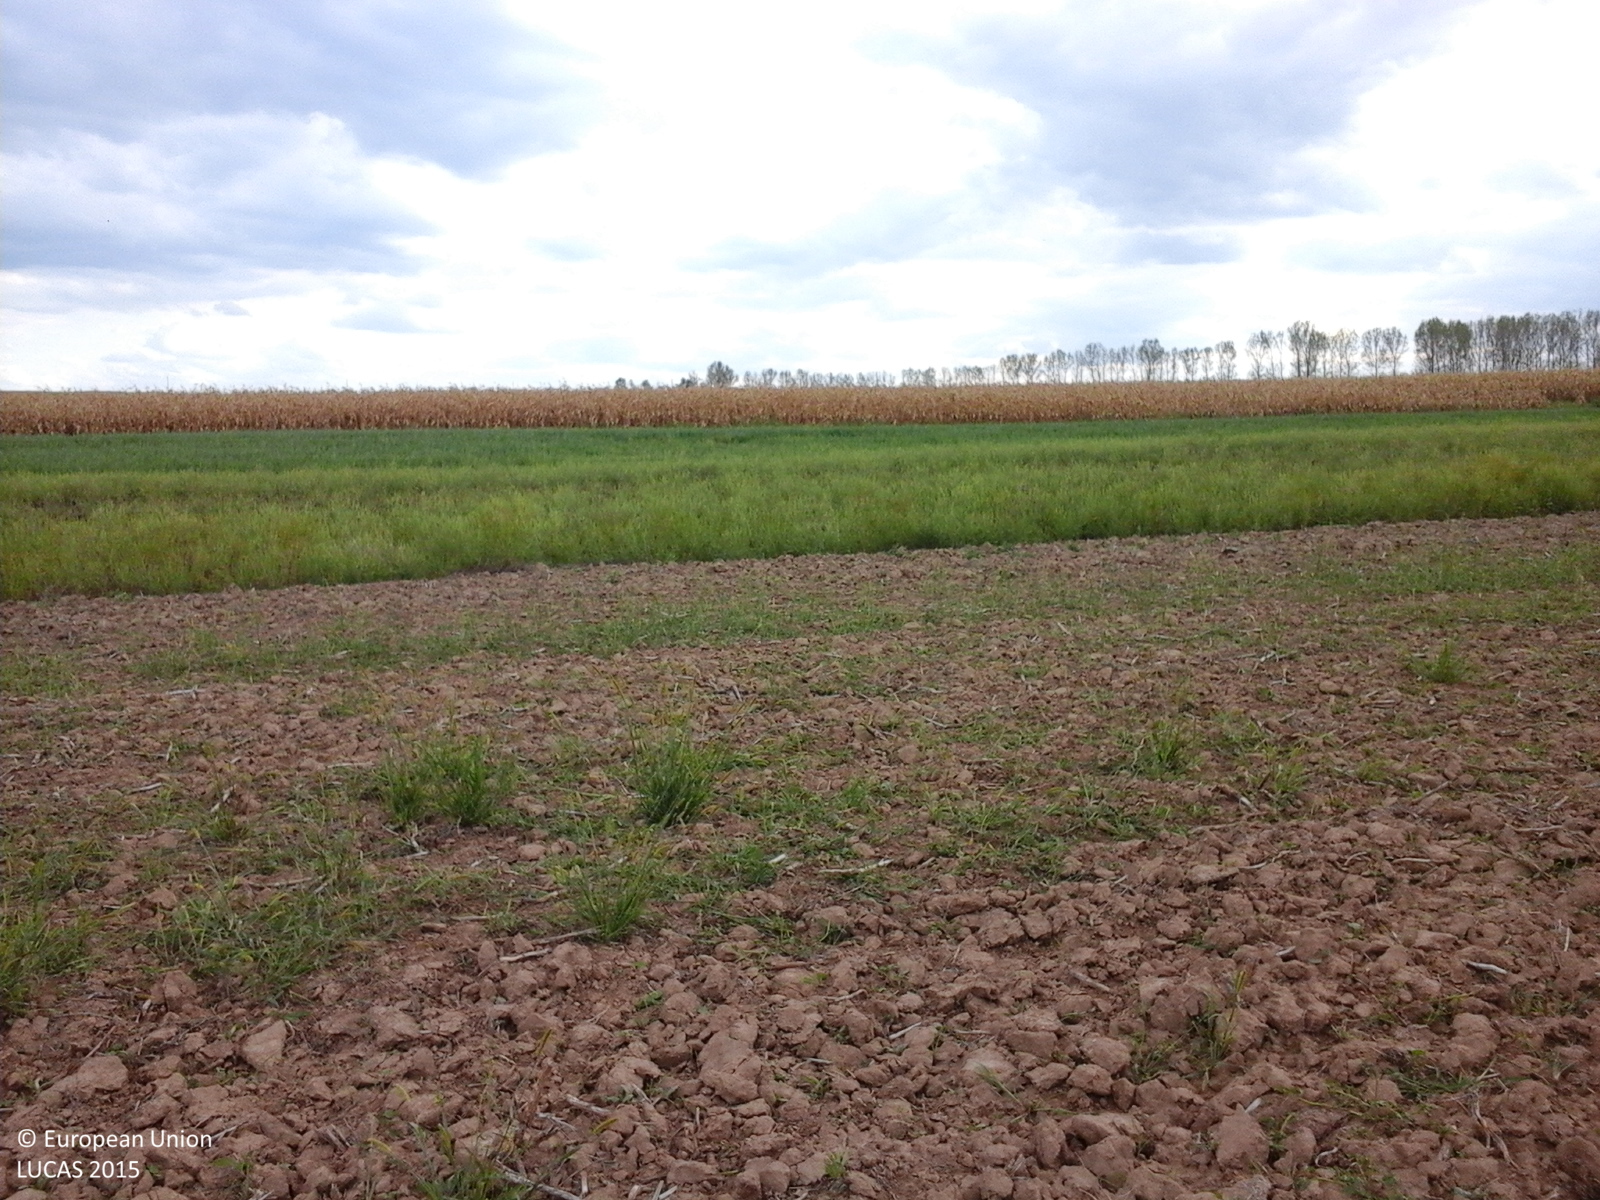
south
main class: Cropland
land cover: Rape and turnip rape
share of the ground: 10 - 25 %
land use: Agriculture (excluding fallow land and kitchen gardens)
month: September
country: RO
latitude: 47.4938
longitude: 22.6291
